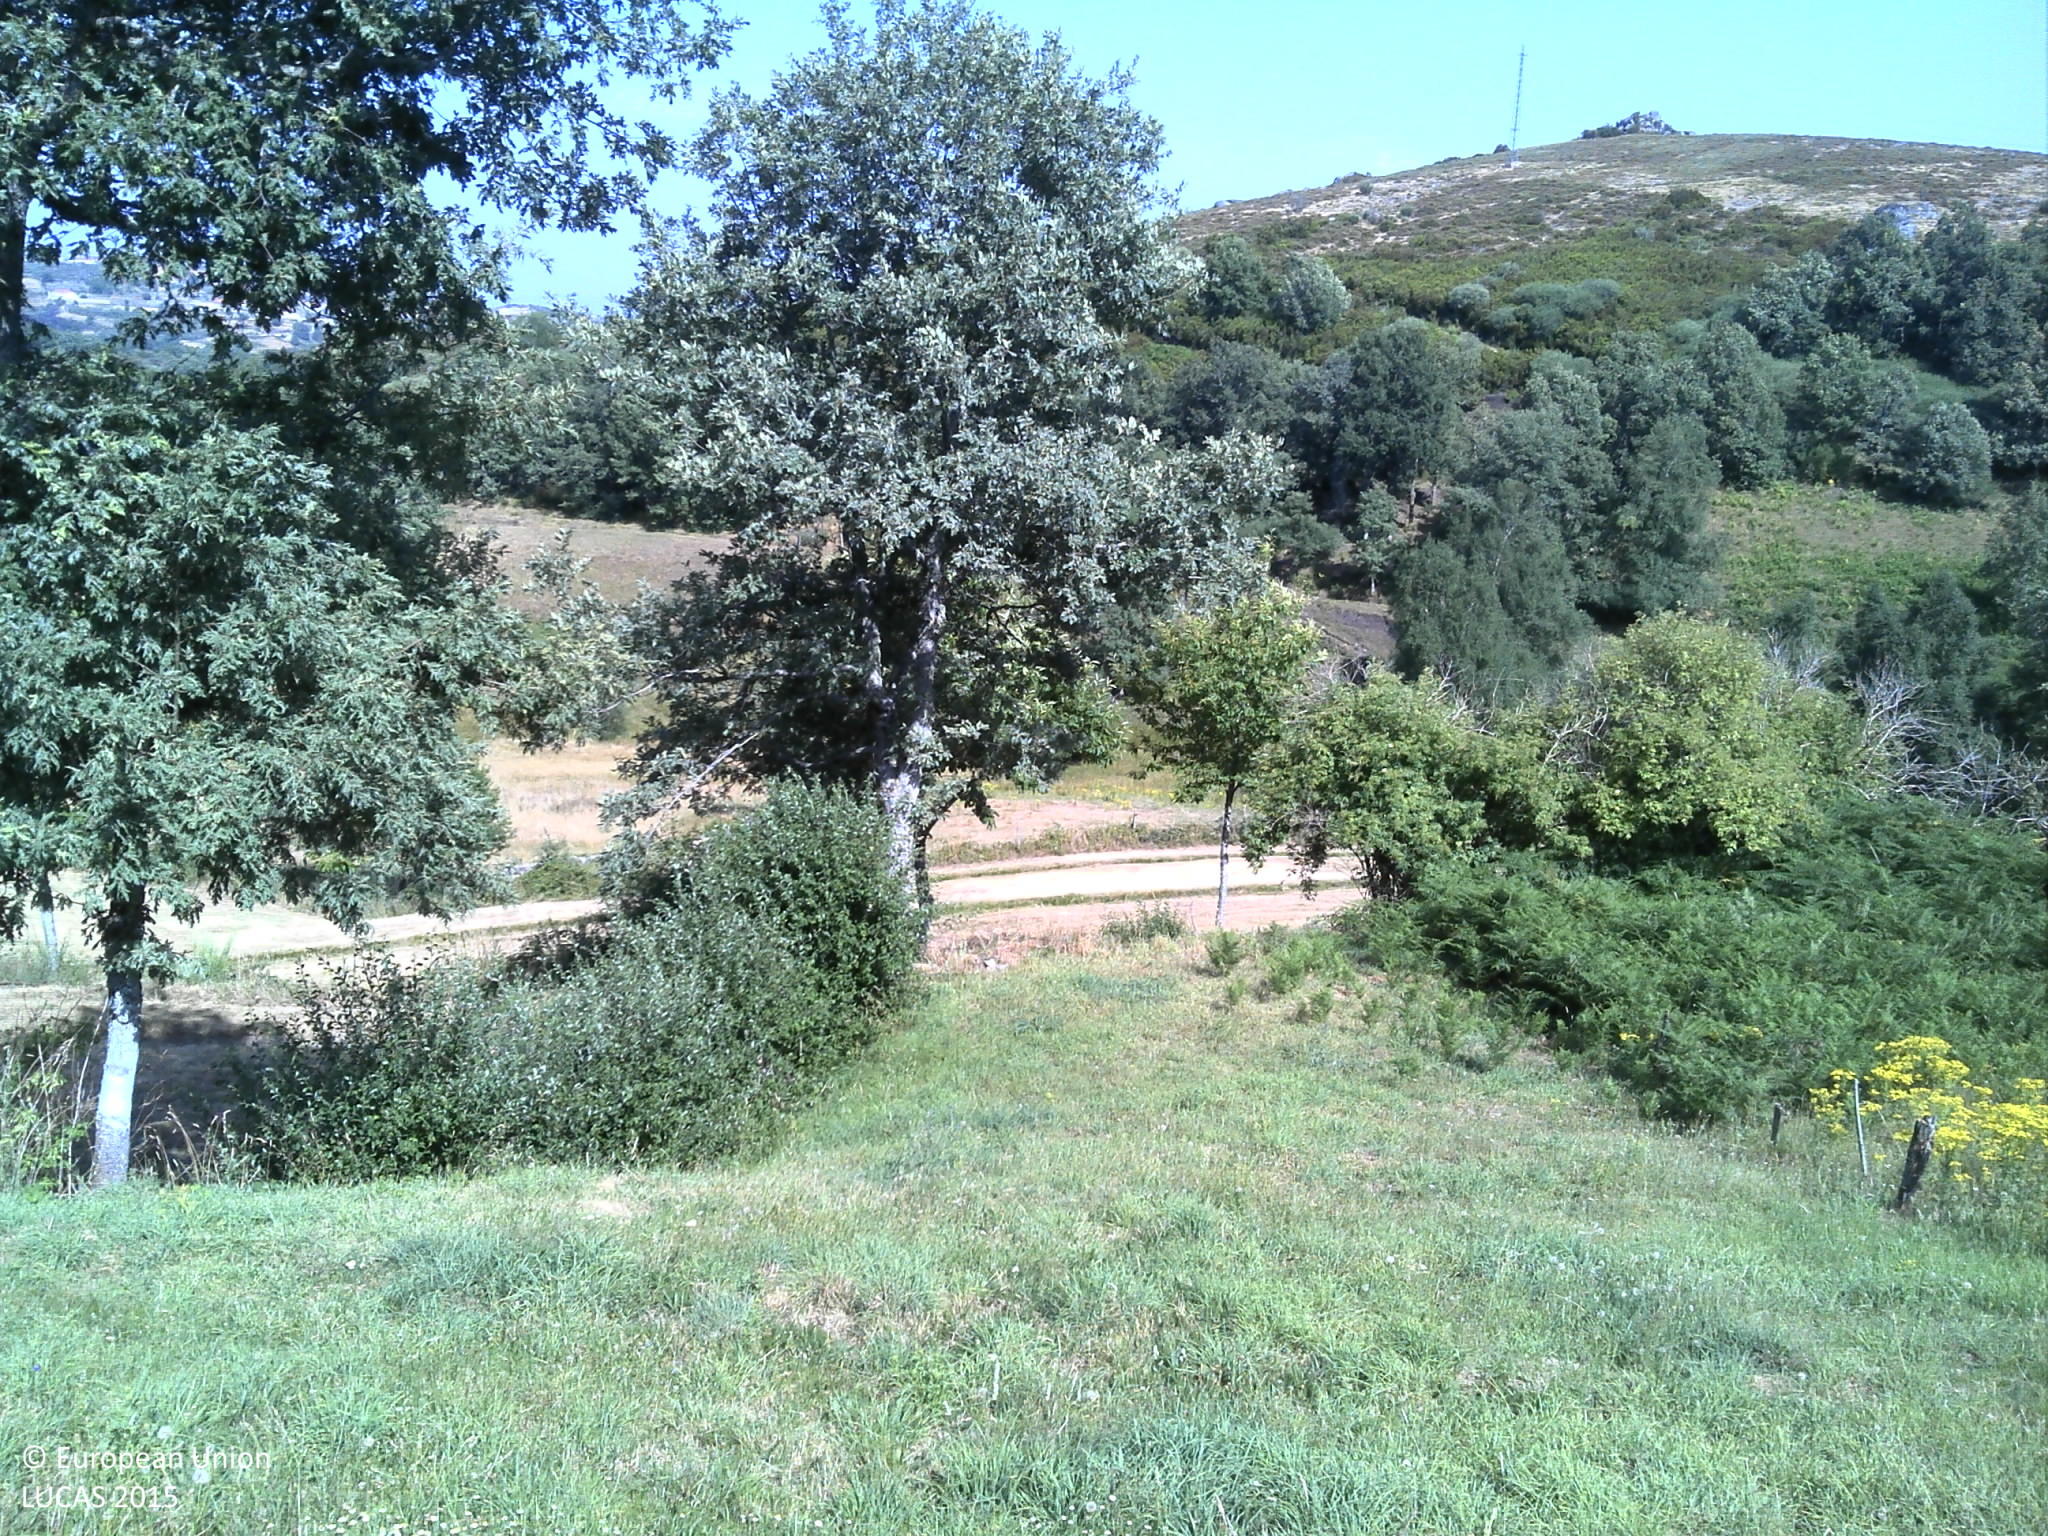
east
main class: Grassland
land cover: Grassland without tree/shrub cover
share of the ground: > 75 %
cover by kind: herbaceous plants 100 %
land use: Agriculture (excluding fallow land and kitchen gardens)
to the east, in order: Grassland without tree/shrub cover; Dry stone walls; Fences; Grassland without tree/shrub cover; Fences; Grassland without tree/shrub cover; Fences; Grassland without tree/shrub cover; Fences; Grassland without tree/shrub cover; Fences; Grassland without tree/shrub cover; Electric lines; Broadleaved woodland; Rivers and streams; Broadleaved woodland; Tracks; Broadleaved woodland
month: July
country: PT
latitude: 41.7050
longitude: -7.8166
